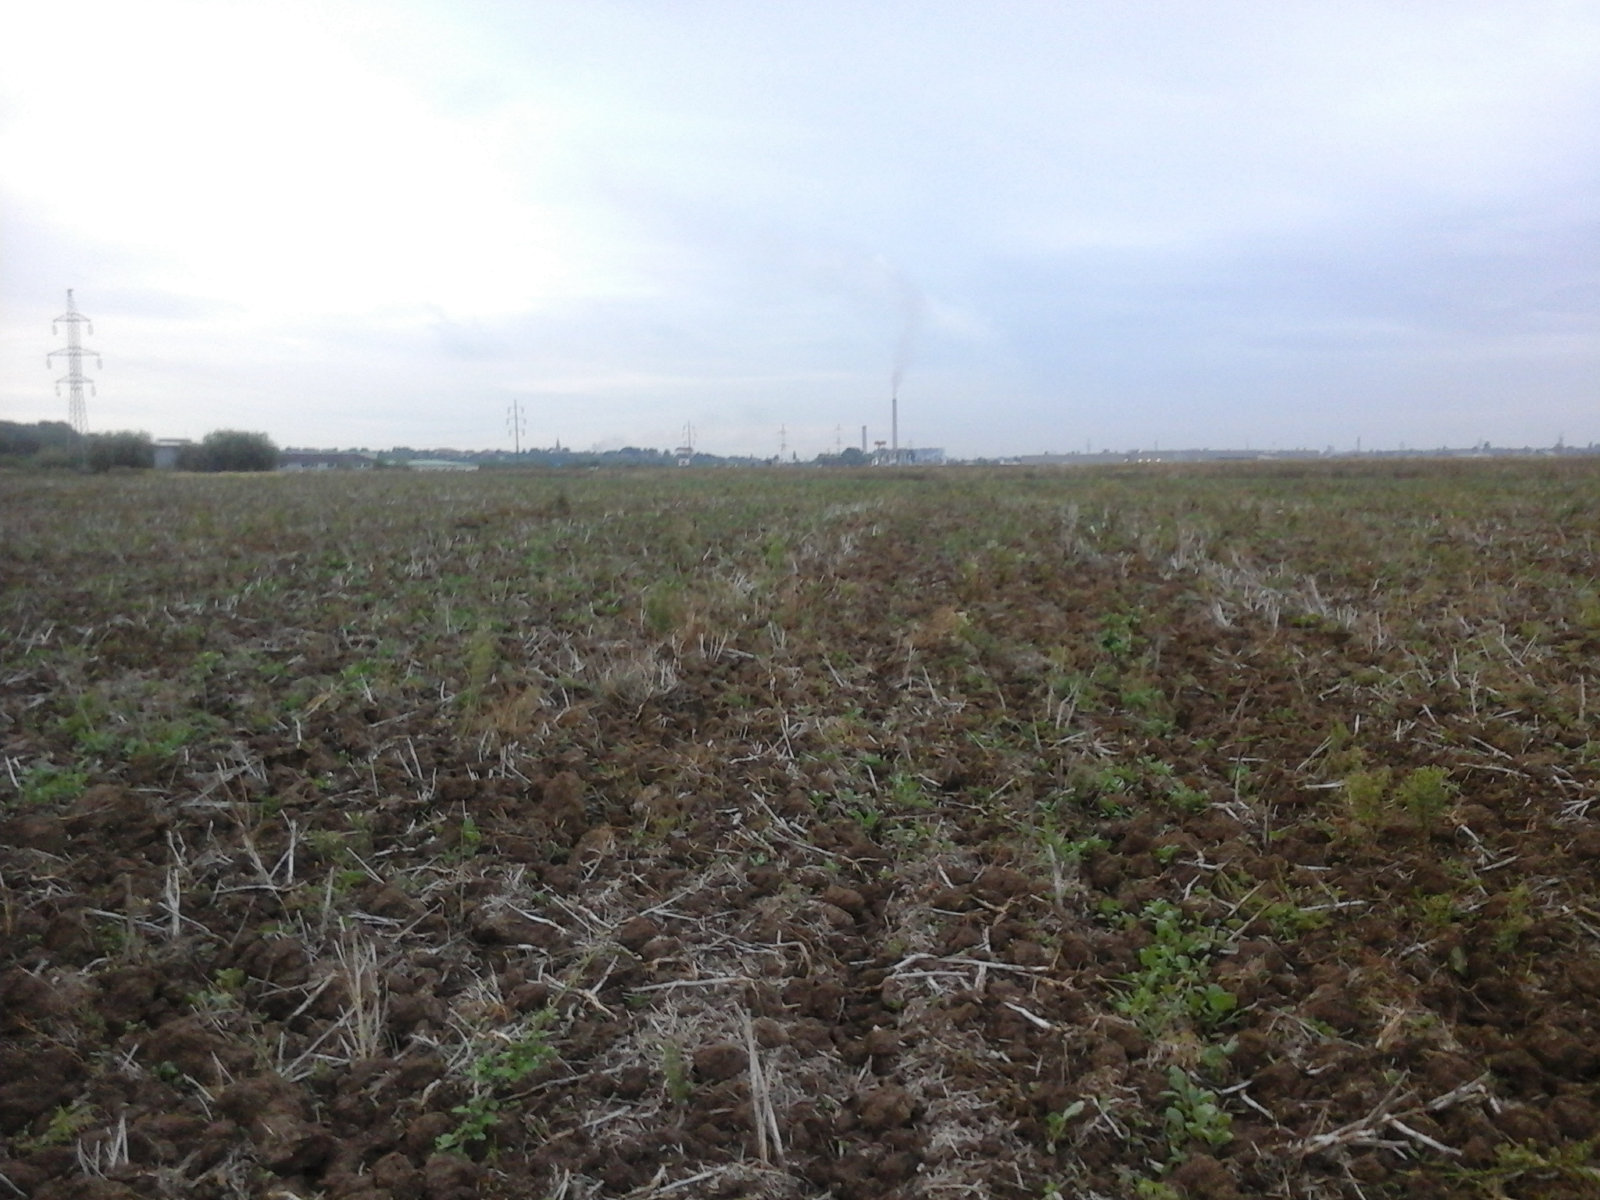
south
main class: Cropland
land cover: Rape and turnip rape
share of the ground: < 10 %
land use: Agriculture (excluding fallow land and kitchen gardens)
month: September
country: RO
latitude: 47.1221
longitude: 21.8960
